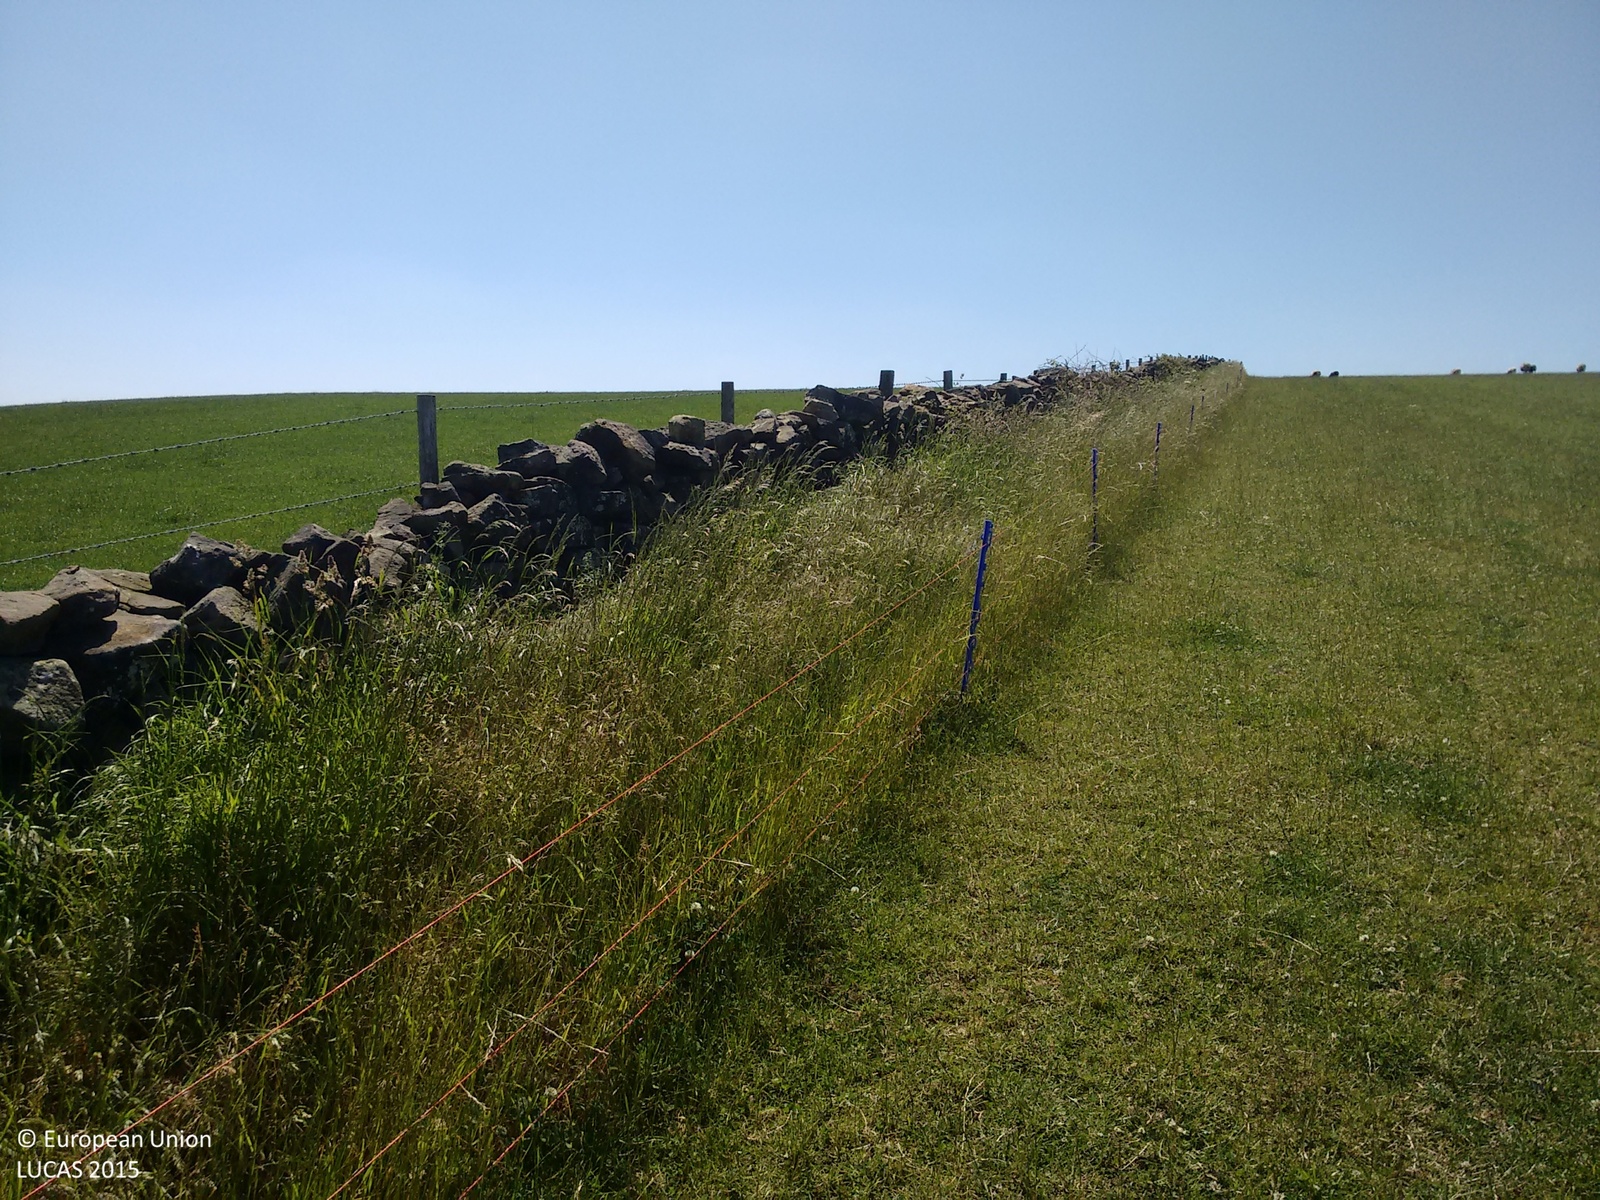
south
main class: Grassland
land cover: Grassland without tree/shrub cover
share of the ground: > 75 %
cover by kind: herbaceous plants 100 %
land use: Agriculture (excluding fallow land and kitchen gardens)
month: June
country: GB
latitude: 54.4463
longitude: -0.5380
